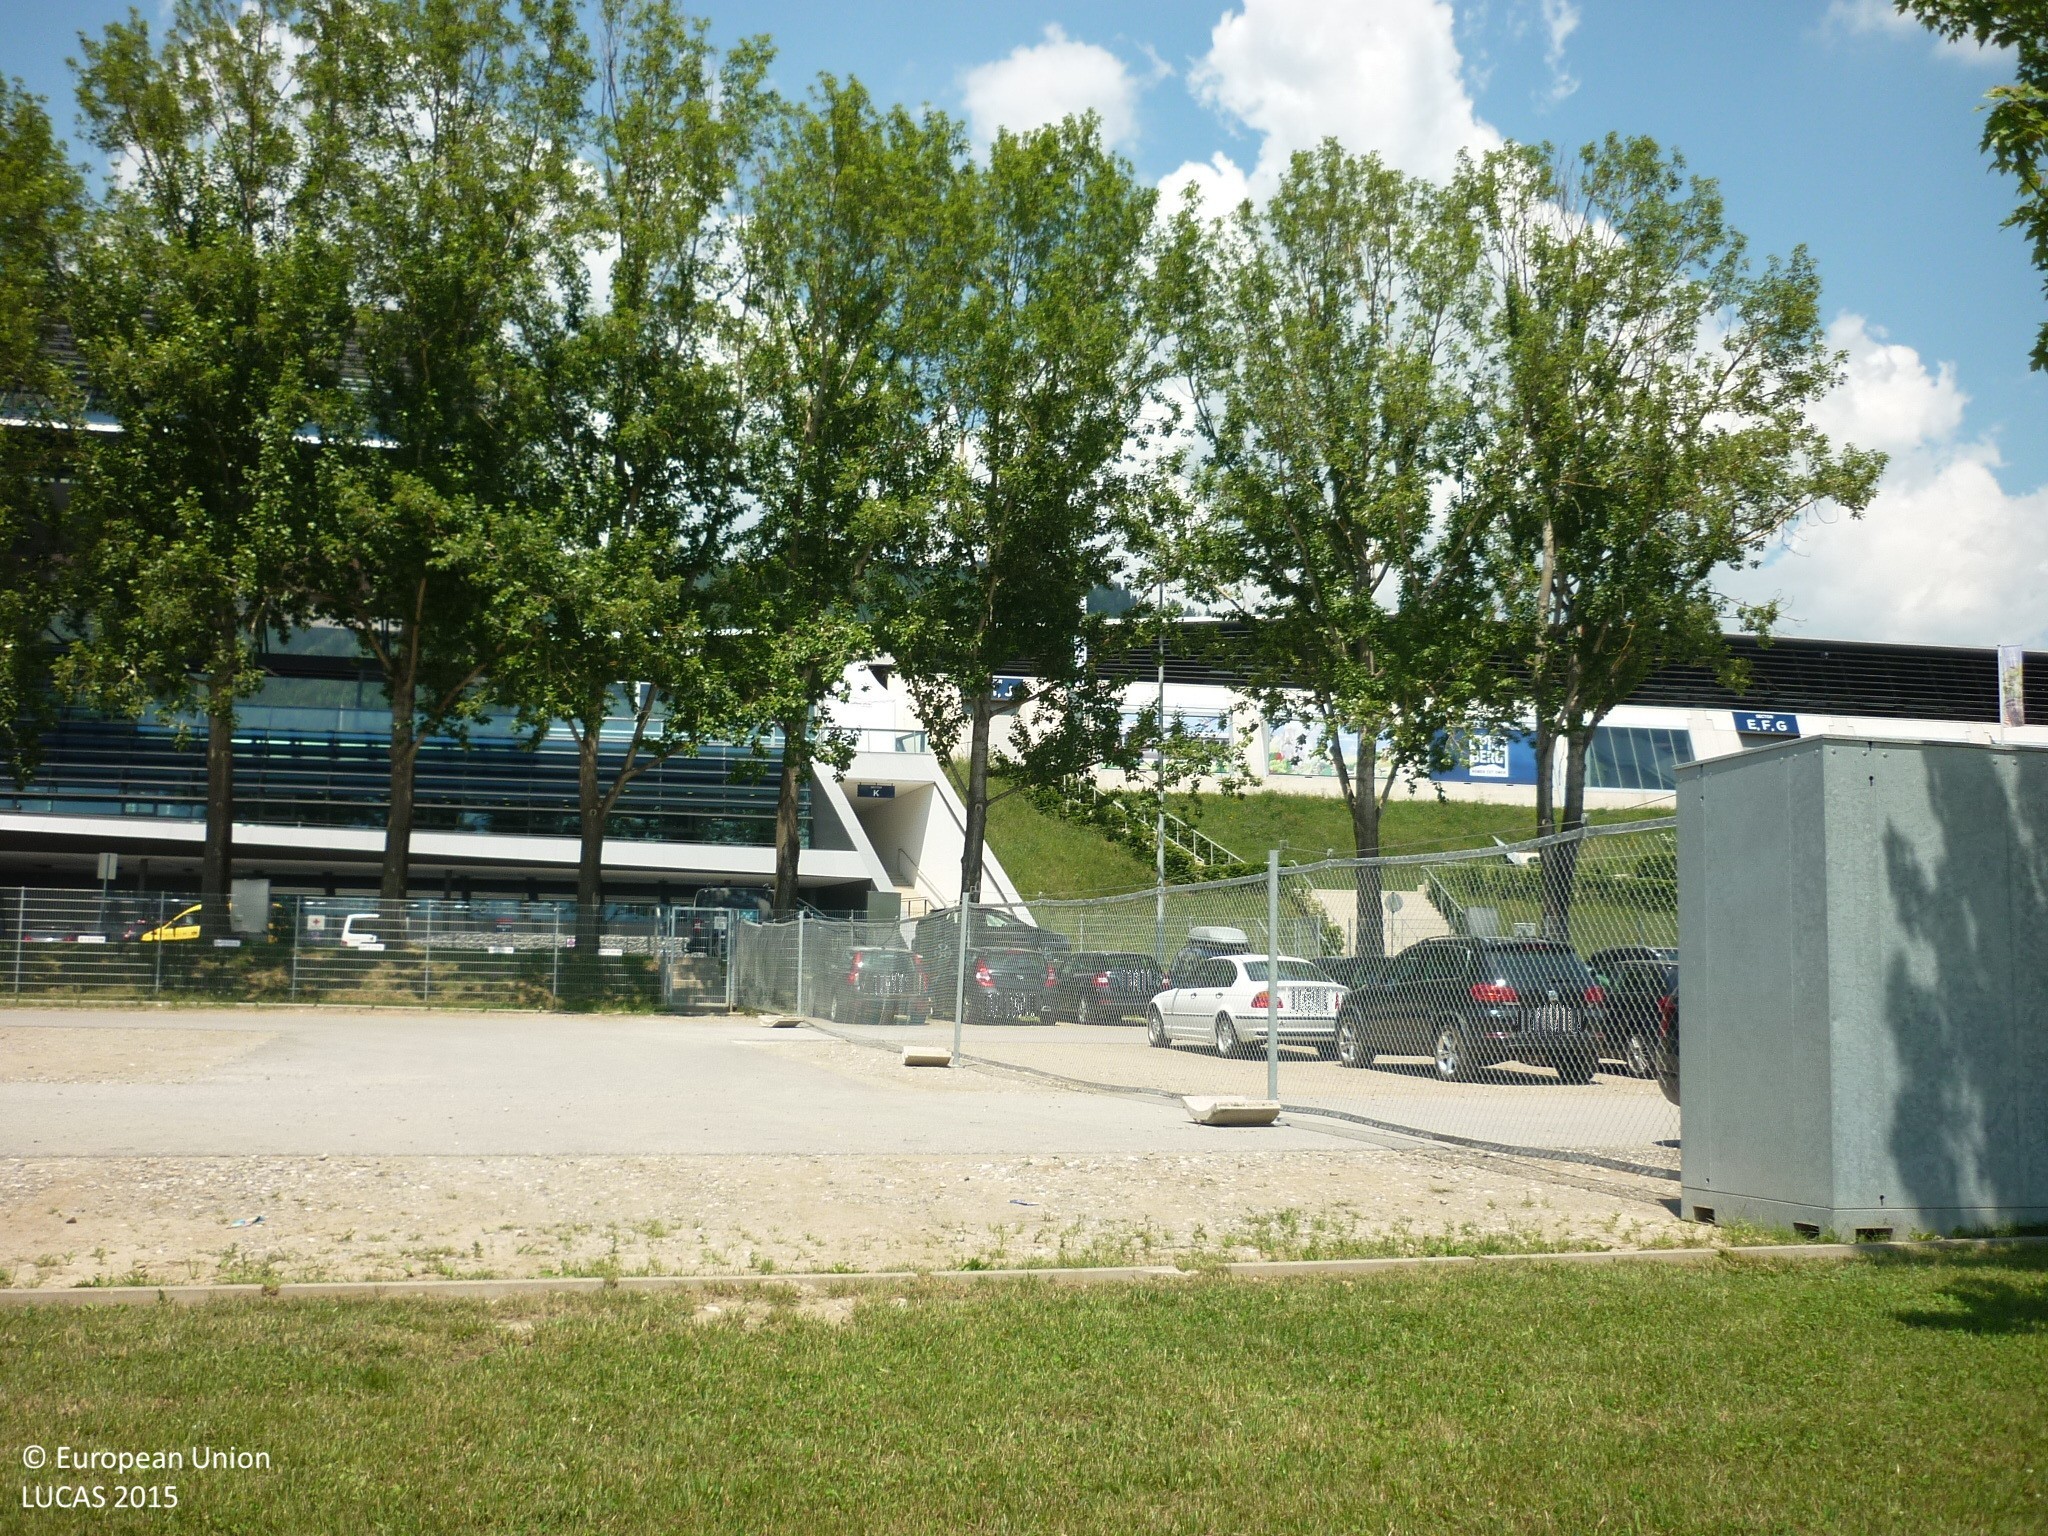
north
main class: Grassland
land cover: Grassland with sparse tree/shrub cover
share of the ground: > 75 %
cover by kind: herbaceous plants 95 %, broadleaved forest trees 5 %
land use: Road transport
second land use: Amenities, museums, leisure
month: July
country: AT
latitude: 47.2190
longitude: 14.7661
